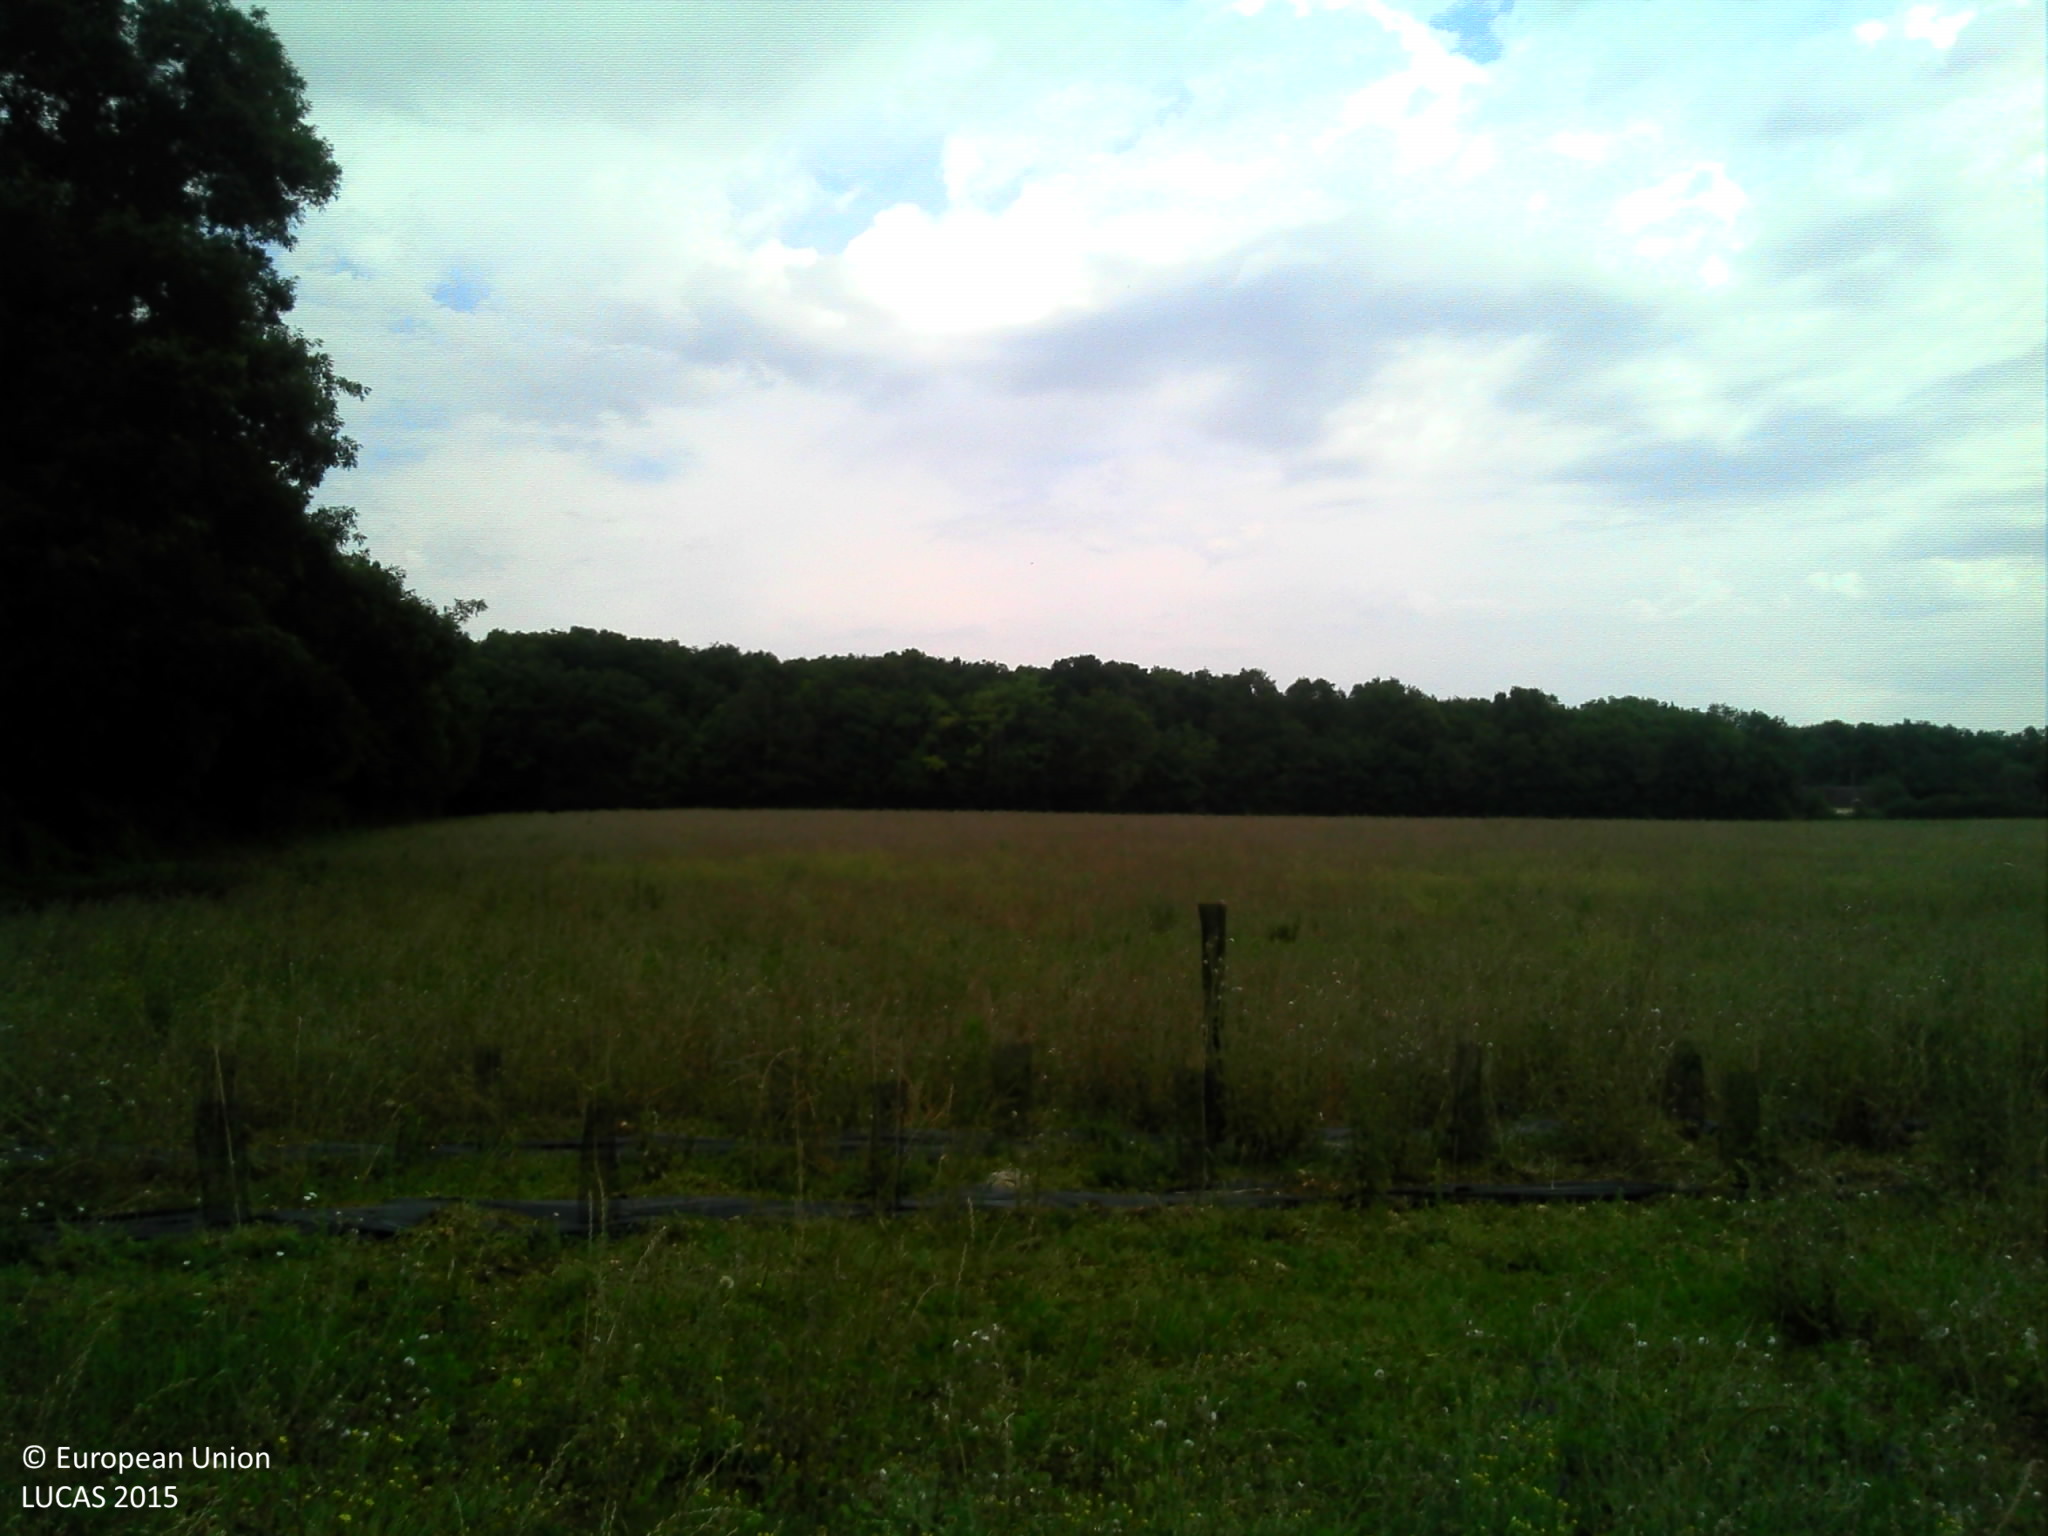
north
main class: Grassland
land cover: Grassland without tree/shrub cover
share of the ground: > 75 %
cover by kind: herbaceous plants 100 %
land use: Agriculture (excluding fallow land and kitchen gardens)
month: July
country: FR
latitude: 47.9358
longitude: 2.8308
